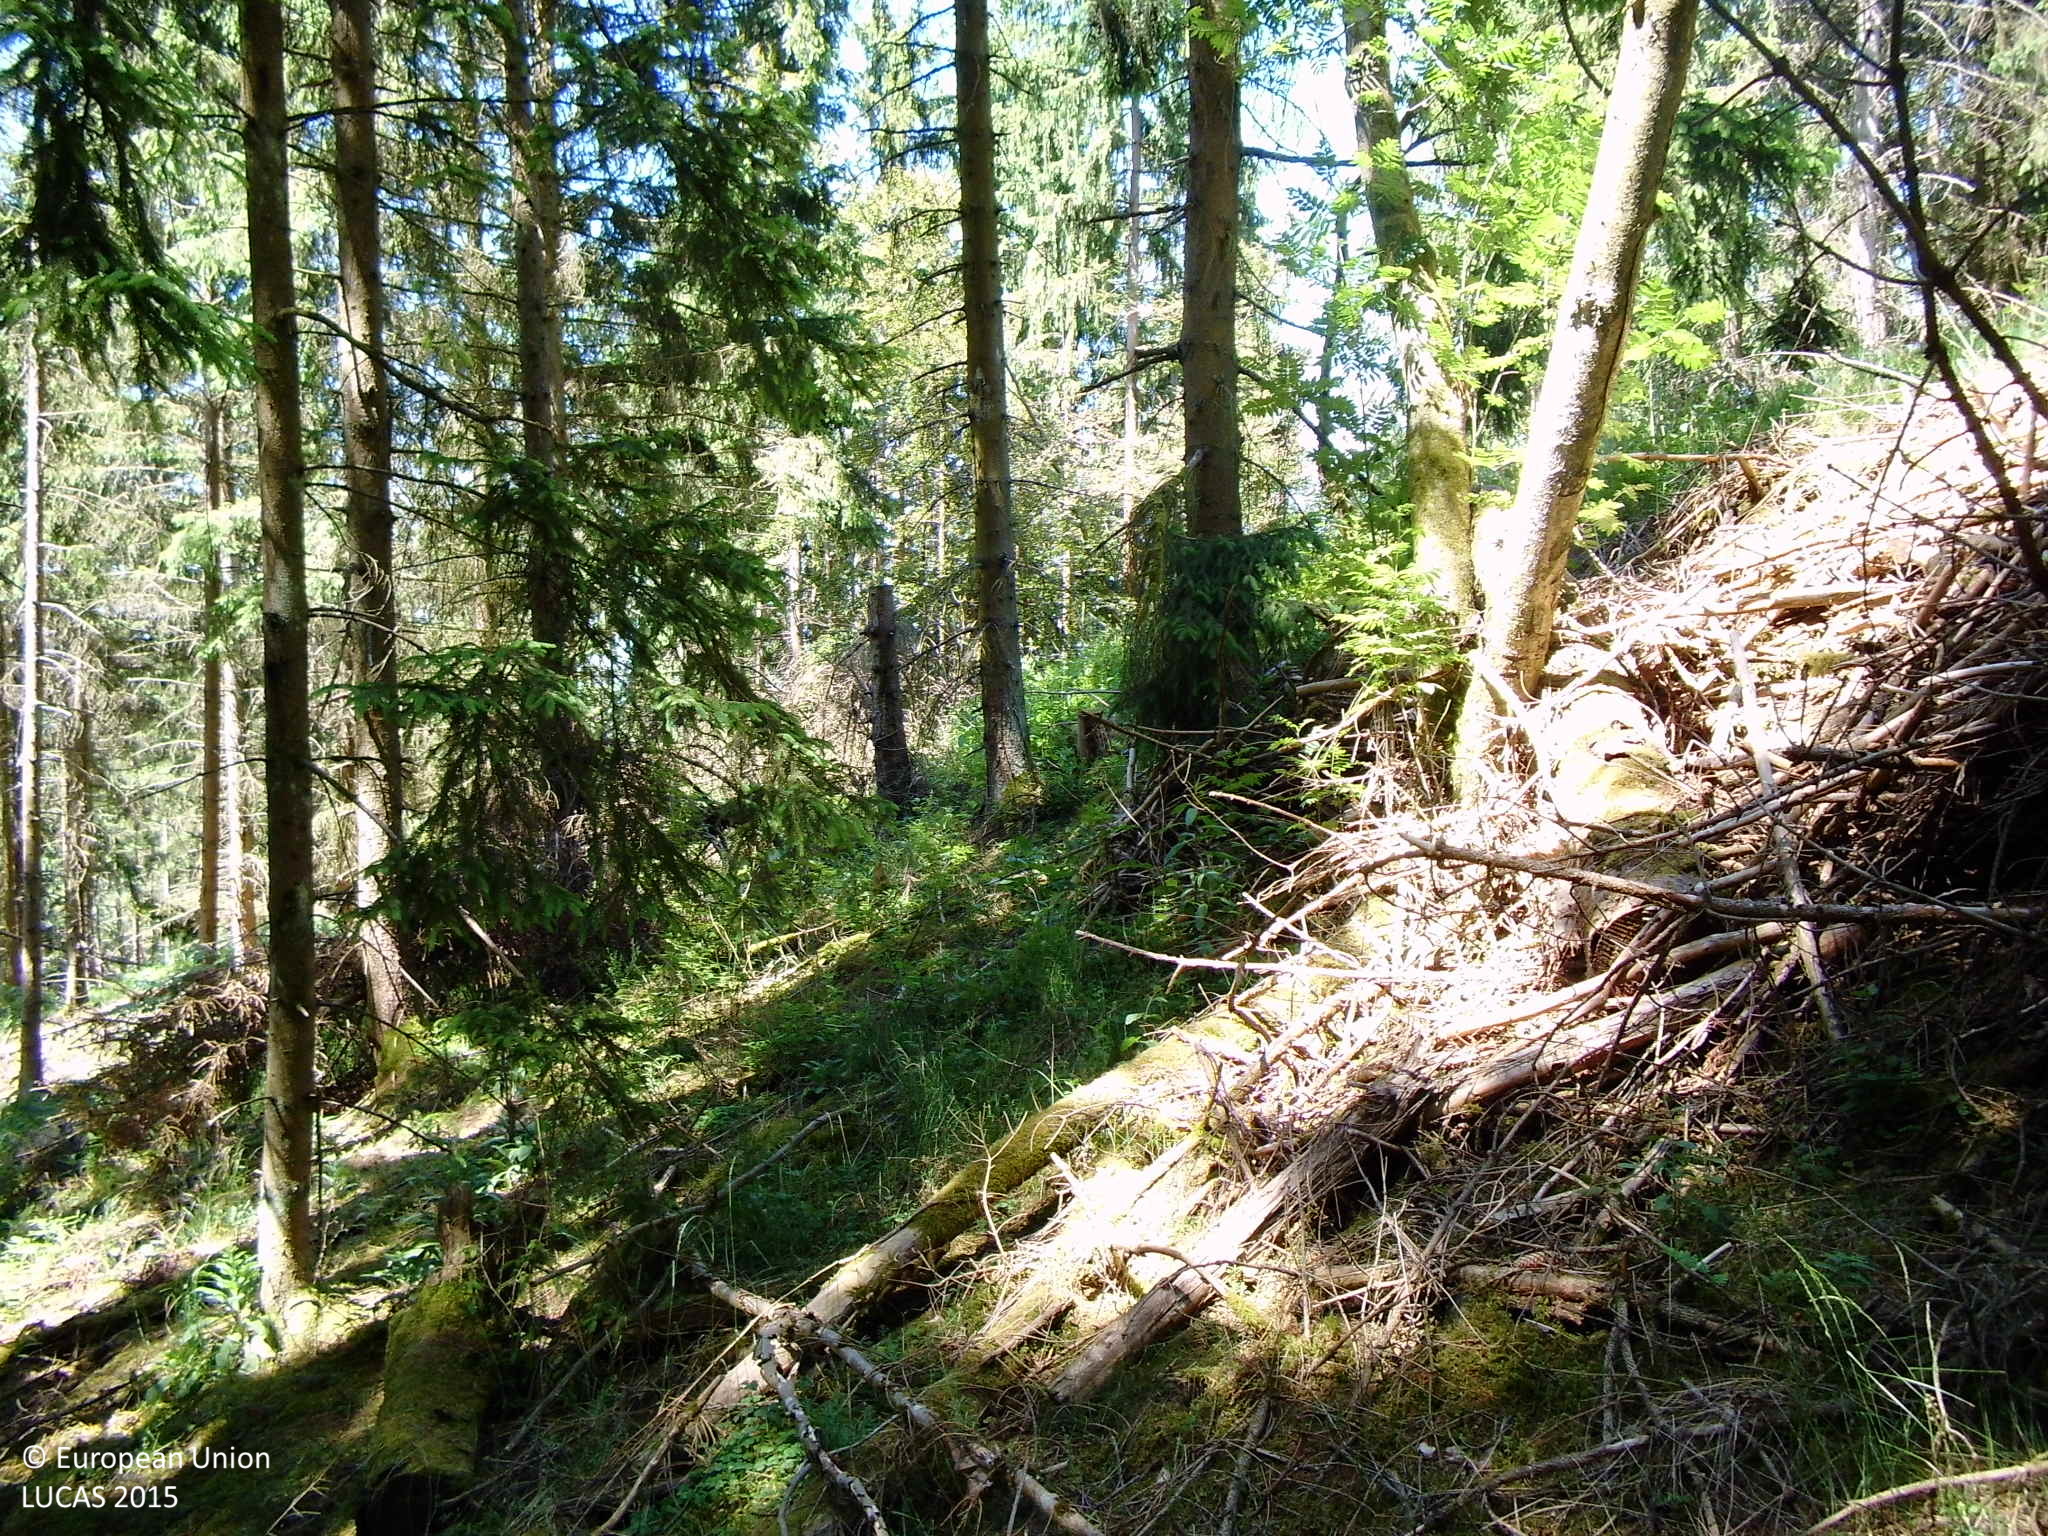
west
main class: Woodland
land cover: Spruce dominated coniferous woodland
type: hemiboreal forest and nemoral coniferous forest and mixed broadleaved-coniferous forest
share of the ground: > 75 %
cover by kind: coniferous forest trees 75 %, broadleaved forest trees 10 %, herbaceous plants 10 %, lichens and mosses 5 %
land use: Forestry
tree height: > 5 m
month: June
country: DE
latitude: 50.9290
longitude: 8.4495
